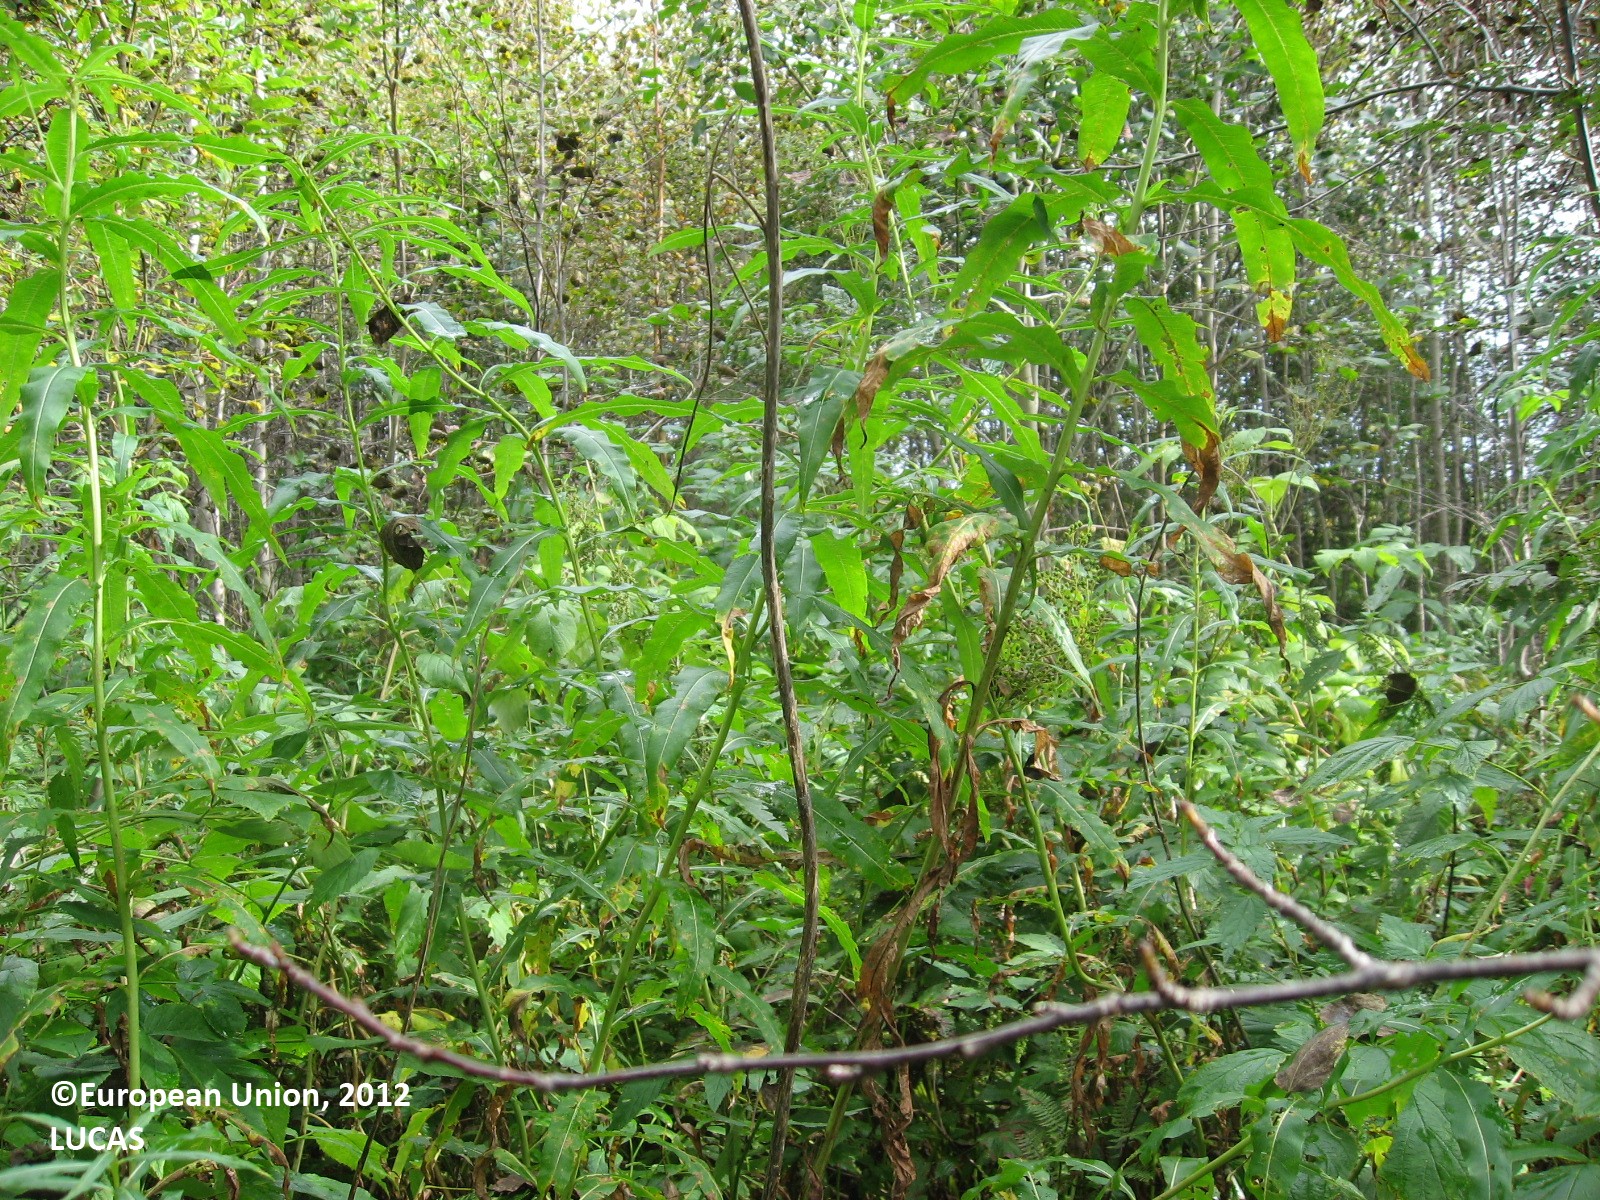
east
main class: Woodland
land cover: Broadleaved woodland
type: boreal forest
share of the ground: > 75 %
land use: Forestry
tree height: > 5 m
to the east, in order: Broadleaved woodland; Grass margins; Temporary grasslands; Electric lines; Temporary grasslands; Grass margins; Ditches and canals; Grass margins; Common wheat
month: September
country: FI
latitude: 60.9459
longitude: 25.2378
